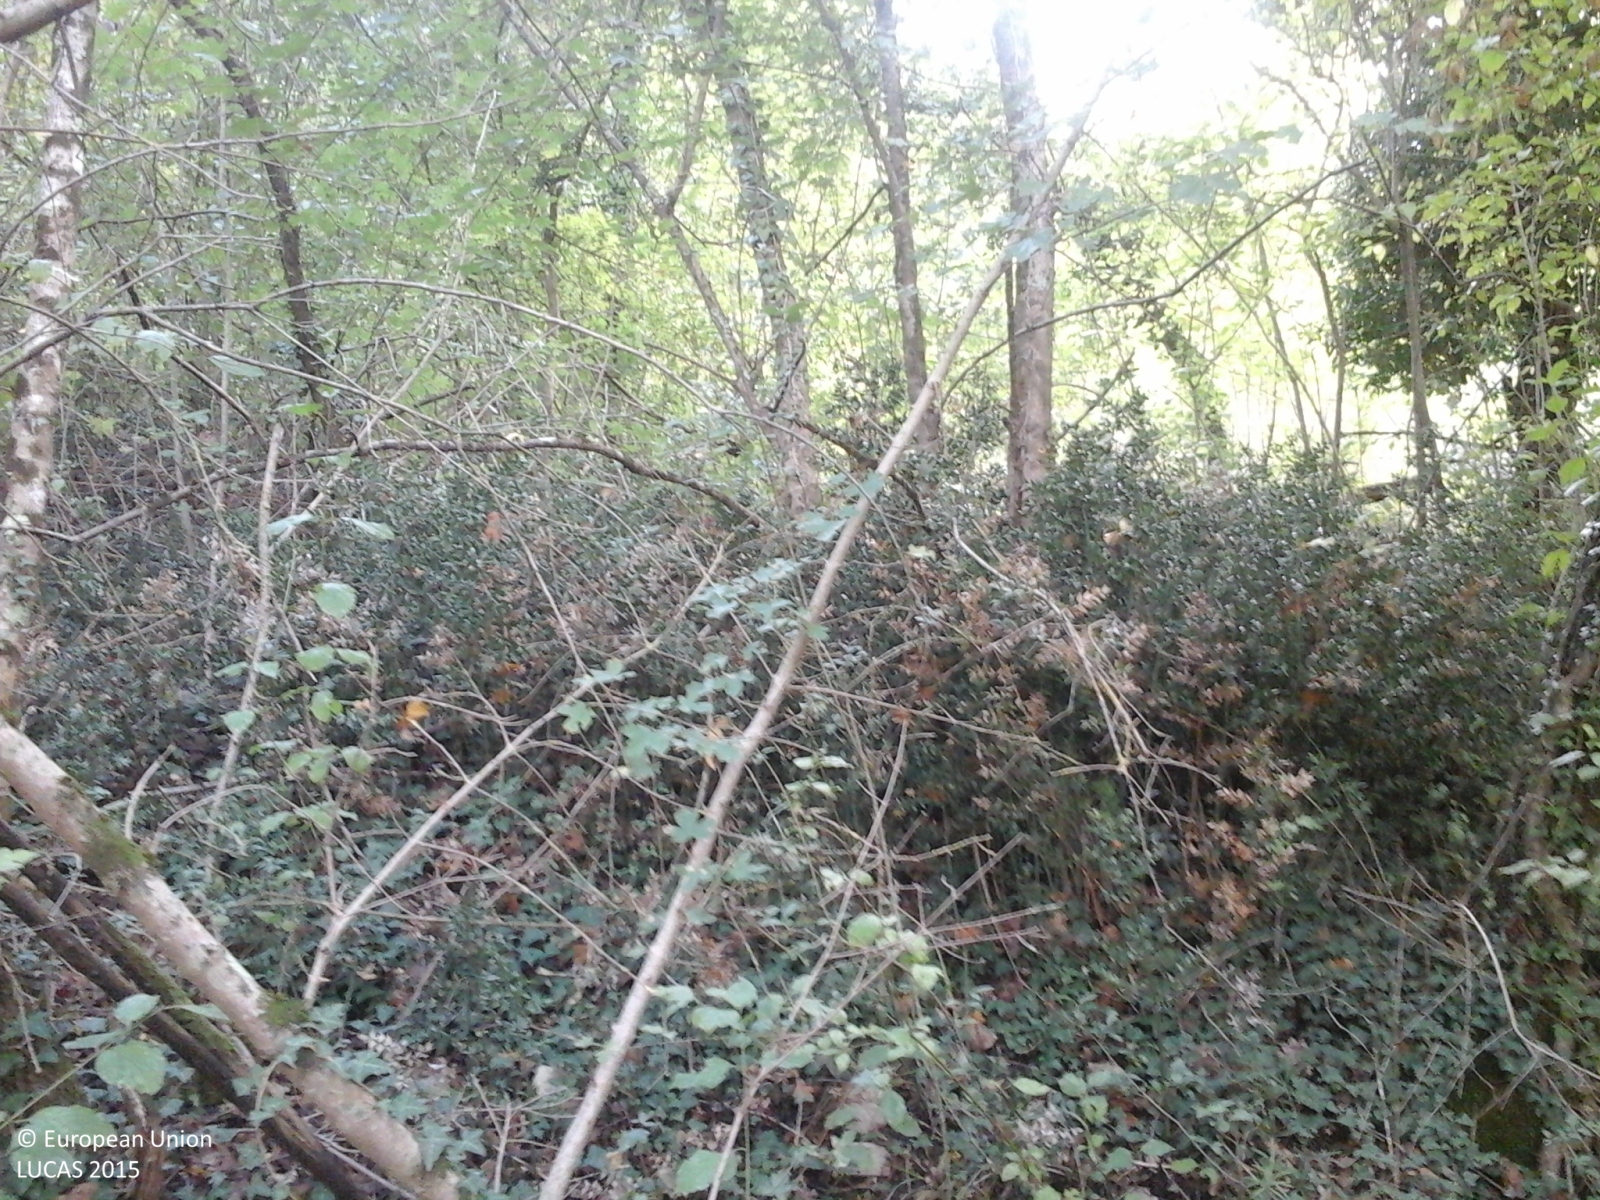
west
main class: Woodland
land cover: Broadleaved woodland
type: thermophilous deciduous forest
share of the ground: > 75 %
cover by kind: broadleaved forest trees 70 %, shrubs 30 %
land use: Forestry
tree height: > 5 m
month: October
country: IT
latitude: 43.4247
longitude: 12.2050
